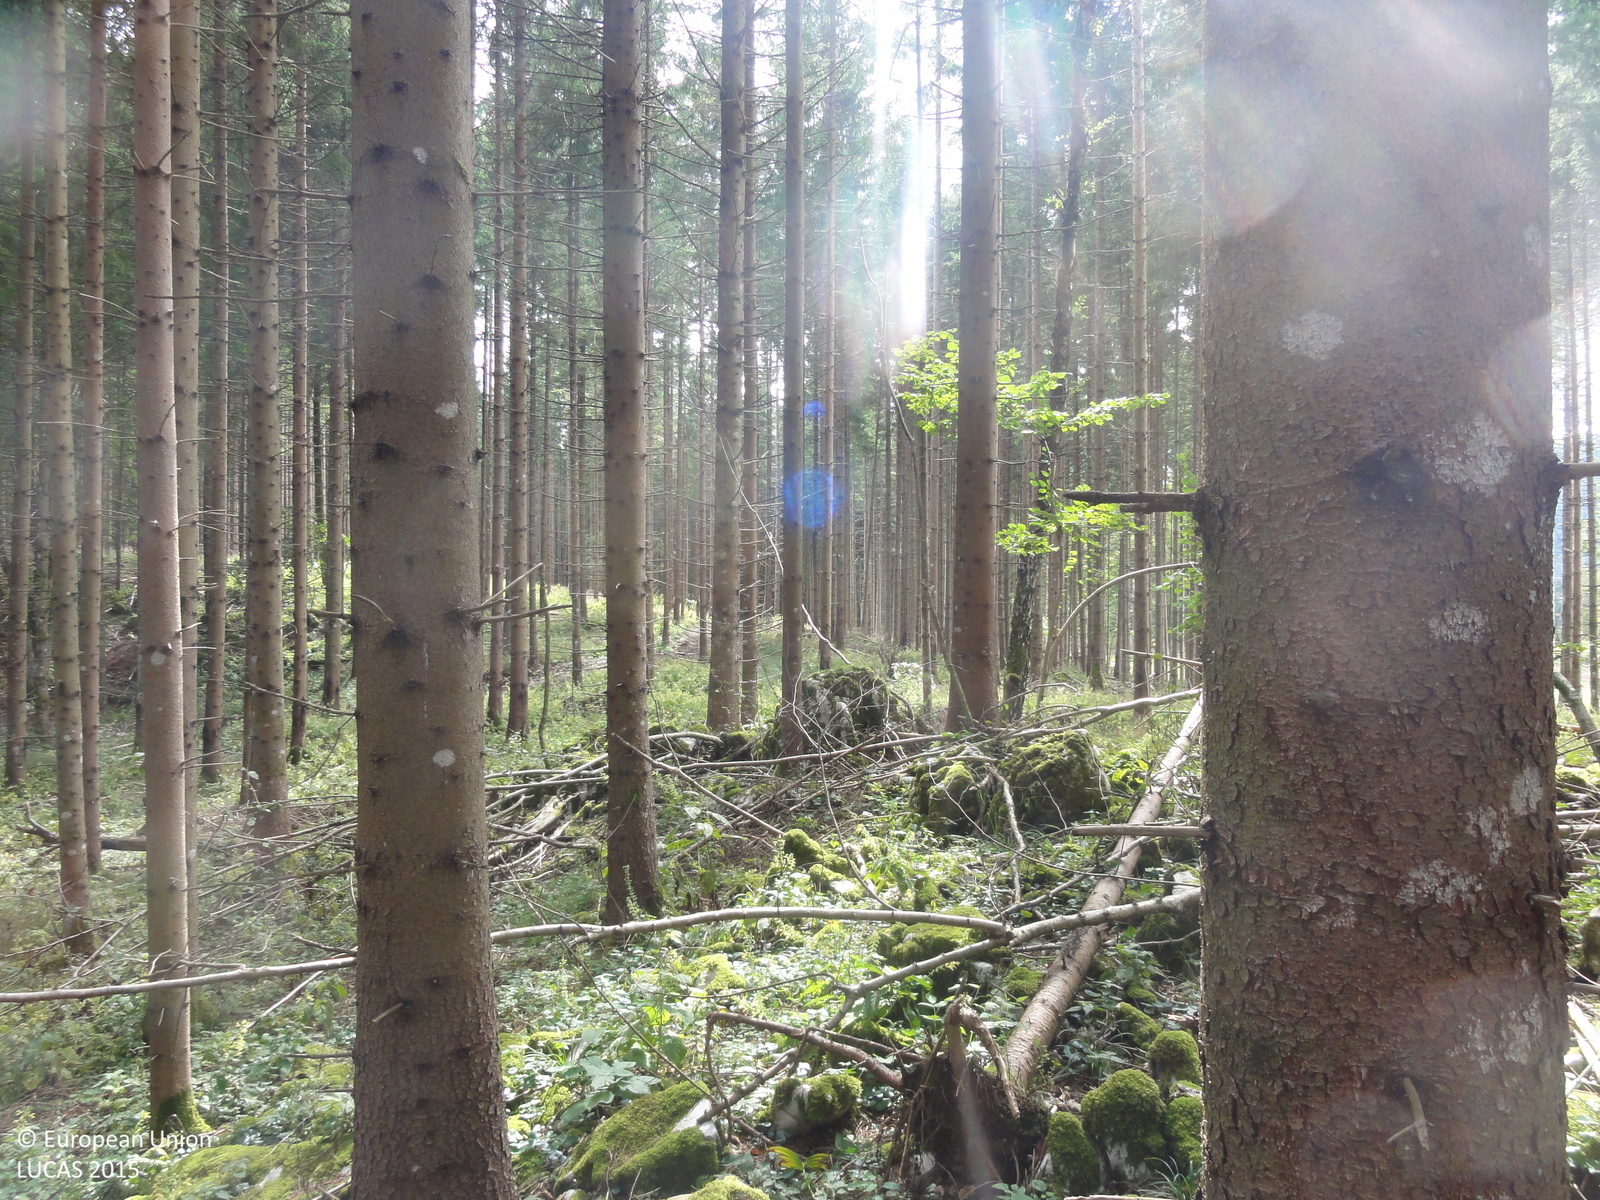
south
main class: Woodland
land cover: Spruce dominated mixed woodland
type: hemiboreal forest and nemoral coniferous forest and mixed broadleaved-coniferous forest
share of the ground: > 75 %
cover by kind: coniferous forest trees 60 %, broadleaved forest trees 25 %, herbaceous plants 5 %
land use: Forestry
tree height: > 5 m
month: September
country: SI
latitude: 45.5937
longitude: 14.8028
